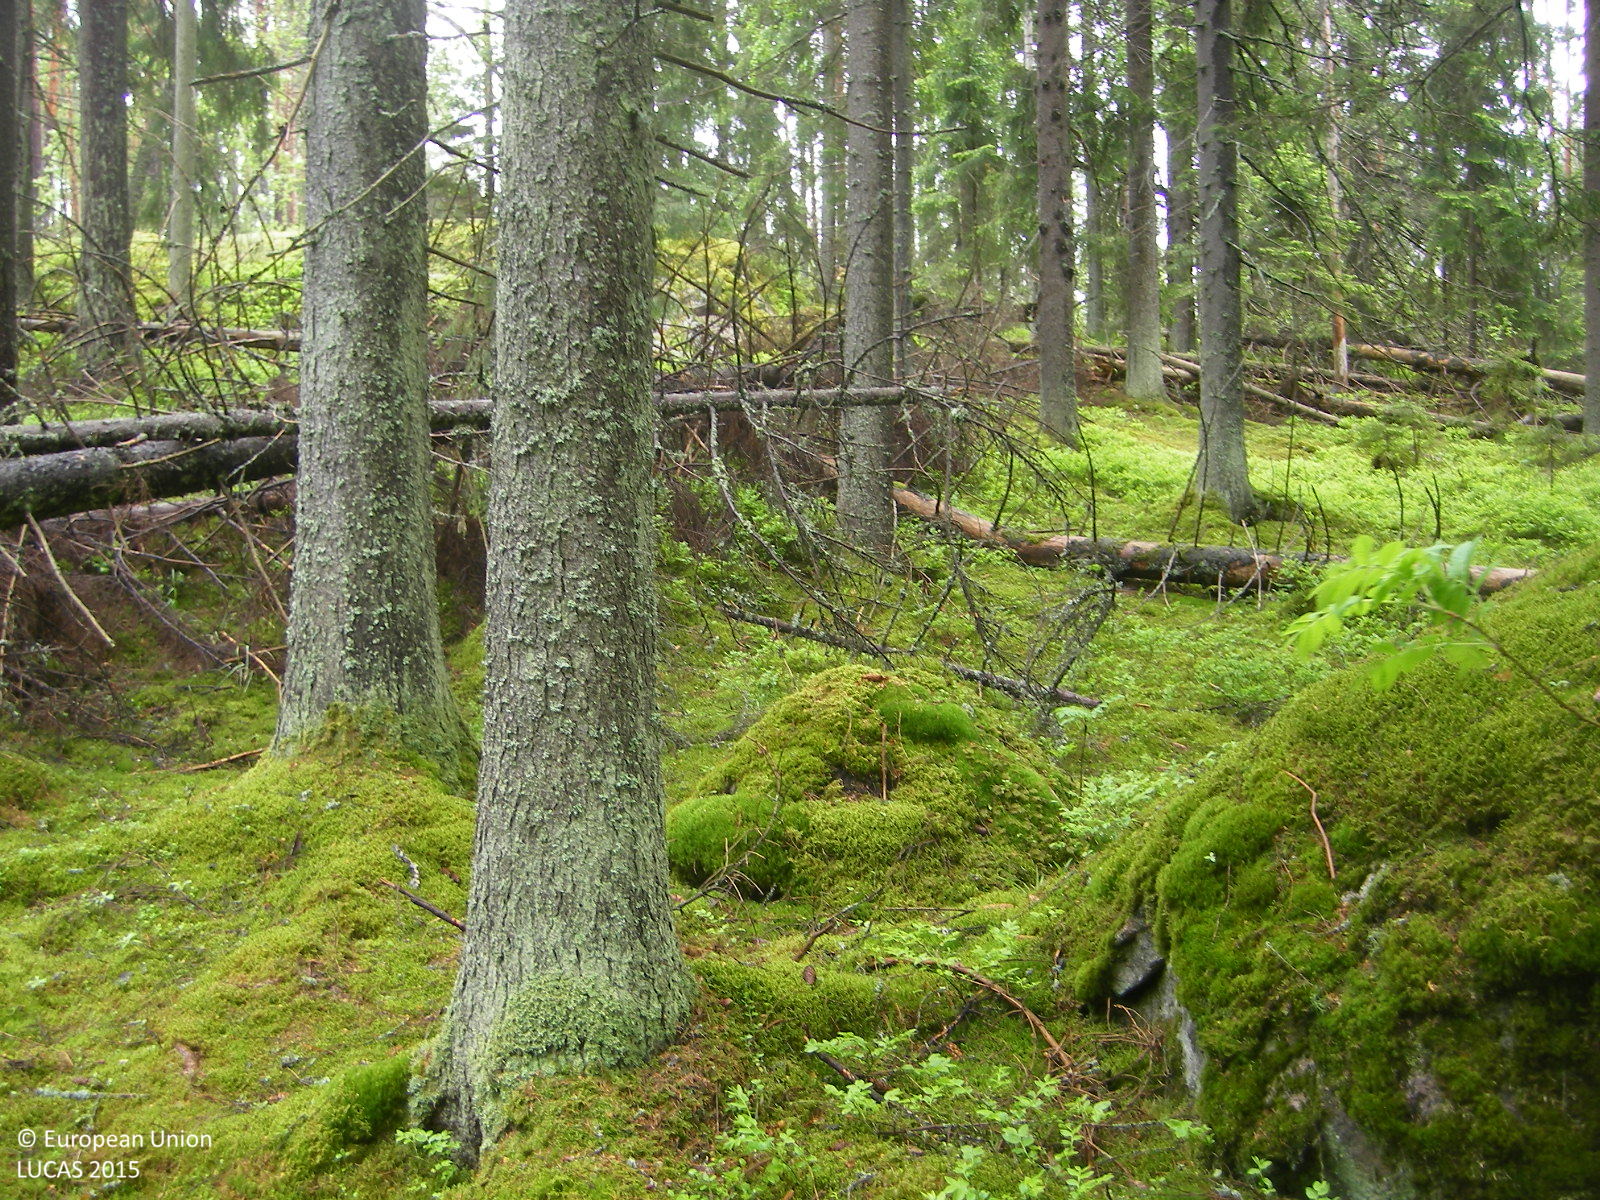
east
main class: Woodland
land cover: Spruce dominated coniferous woodland
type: boreal forest
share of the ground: > 75 %
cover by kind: coniferous forest trees 75 %, shrubs 15 %, lichens and mosses 10 %
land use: Amenities, museums, leisure
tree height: > 5 m
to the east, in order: Spruce dominated coniferous woodland; Other coniferous woodland; Other mixed woodland; Tracks; Spruce dominated mixed woodland
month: June
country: FI
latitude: 60.3237
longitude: 24.6881
